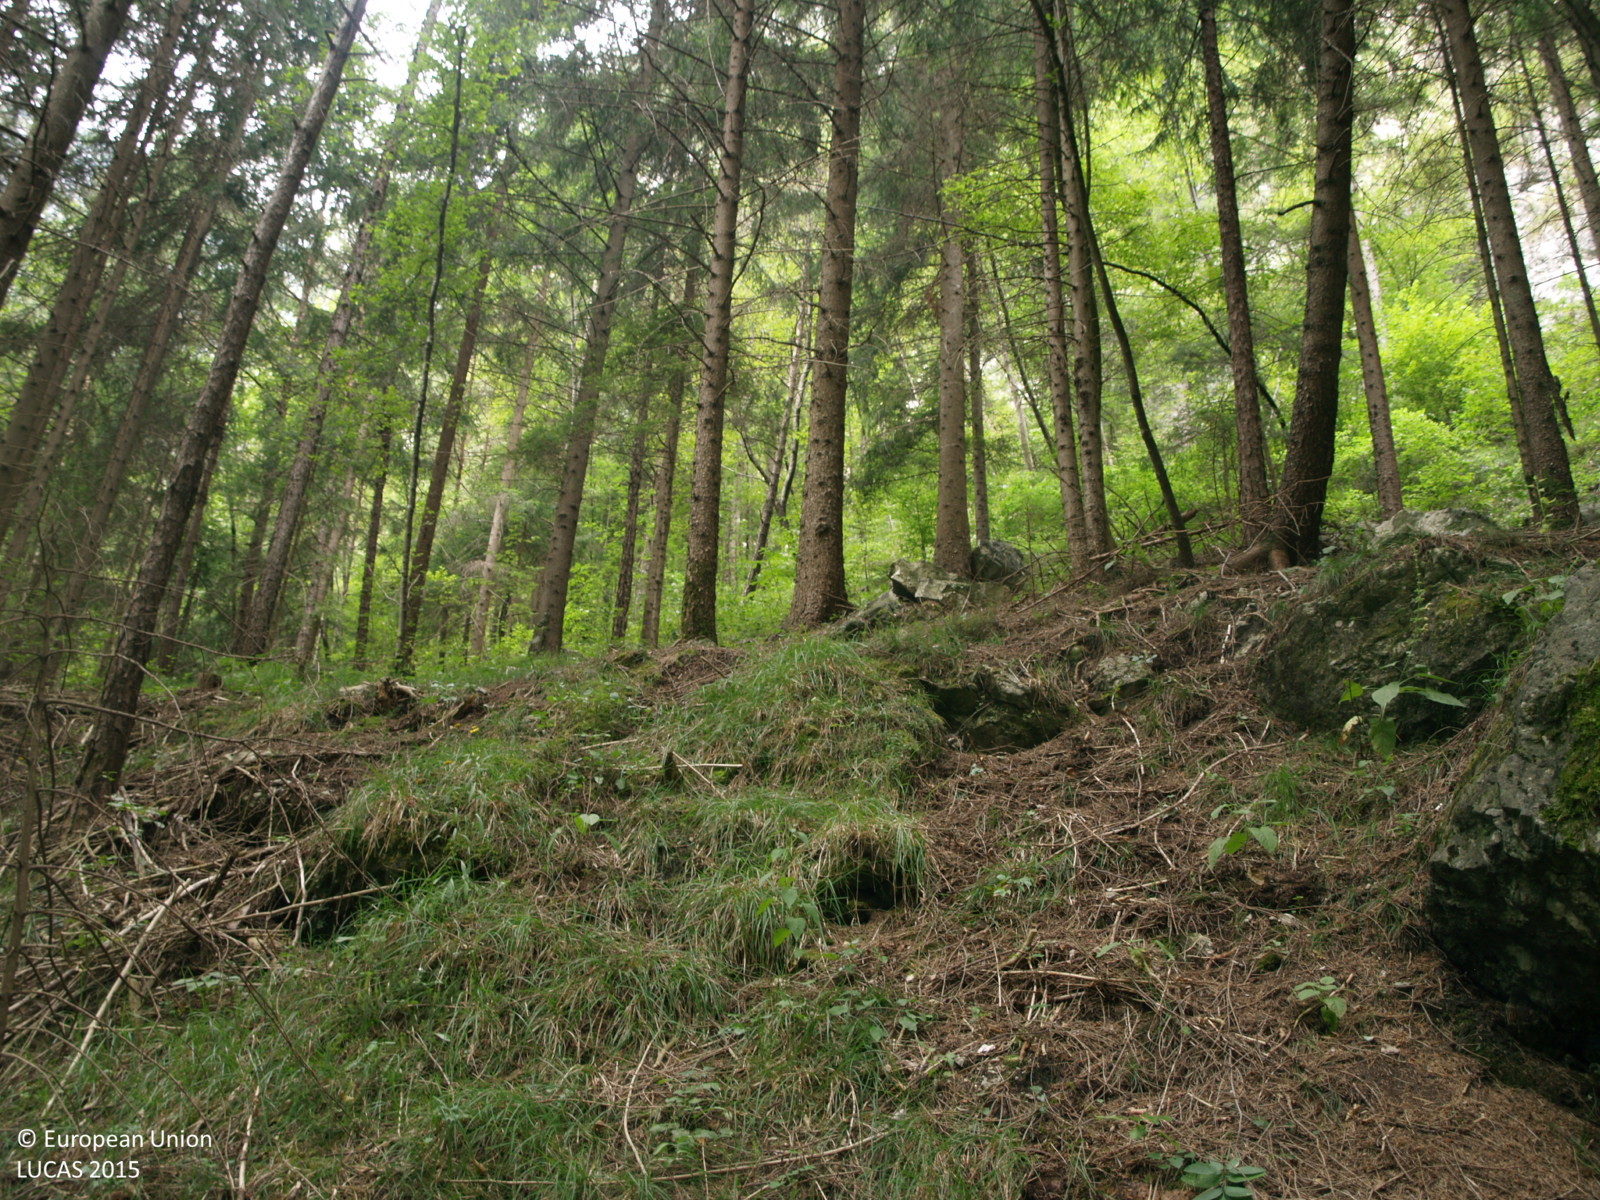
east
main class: Woodland
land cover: Spruce dominated coniferous woodland
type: alpine coniferous forest
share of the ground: > 75 %
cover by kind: coniferous forest trees 90 %, broadleaved forest trees 10 %
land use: Forestry
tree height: > 5 m
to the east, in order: Spruce dominated coniferous woodland
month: May
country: IT
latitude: 46.0249
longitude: 10.6579
